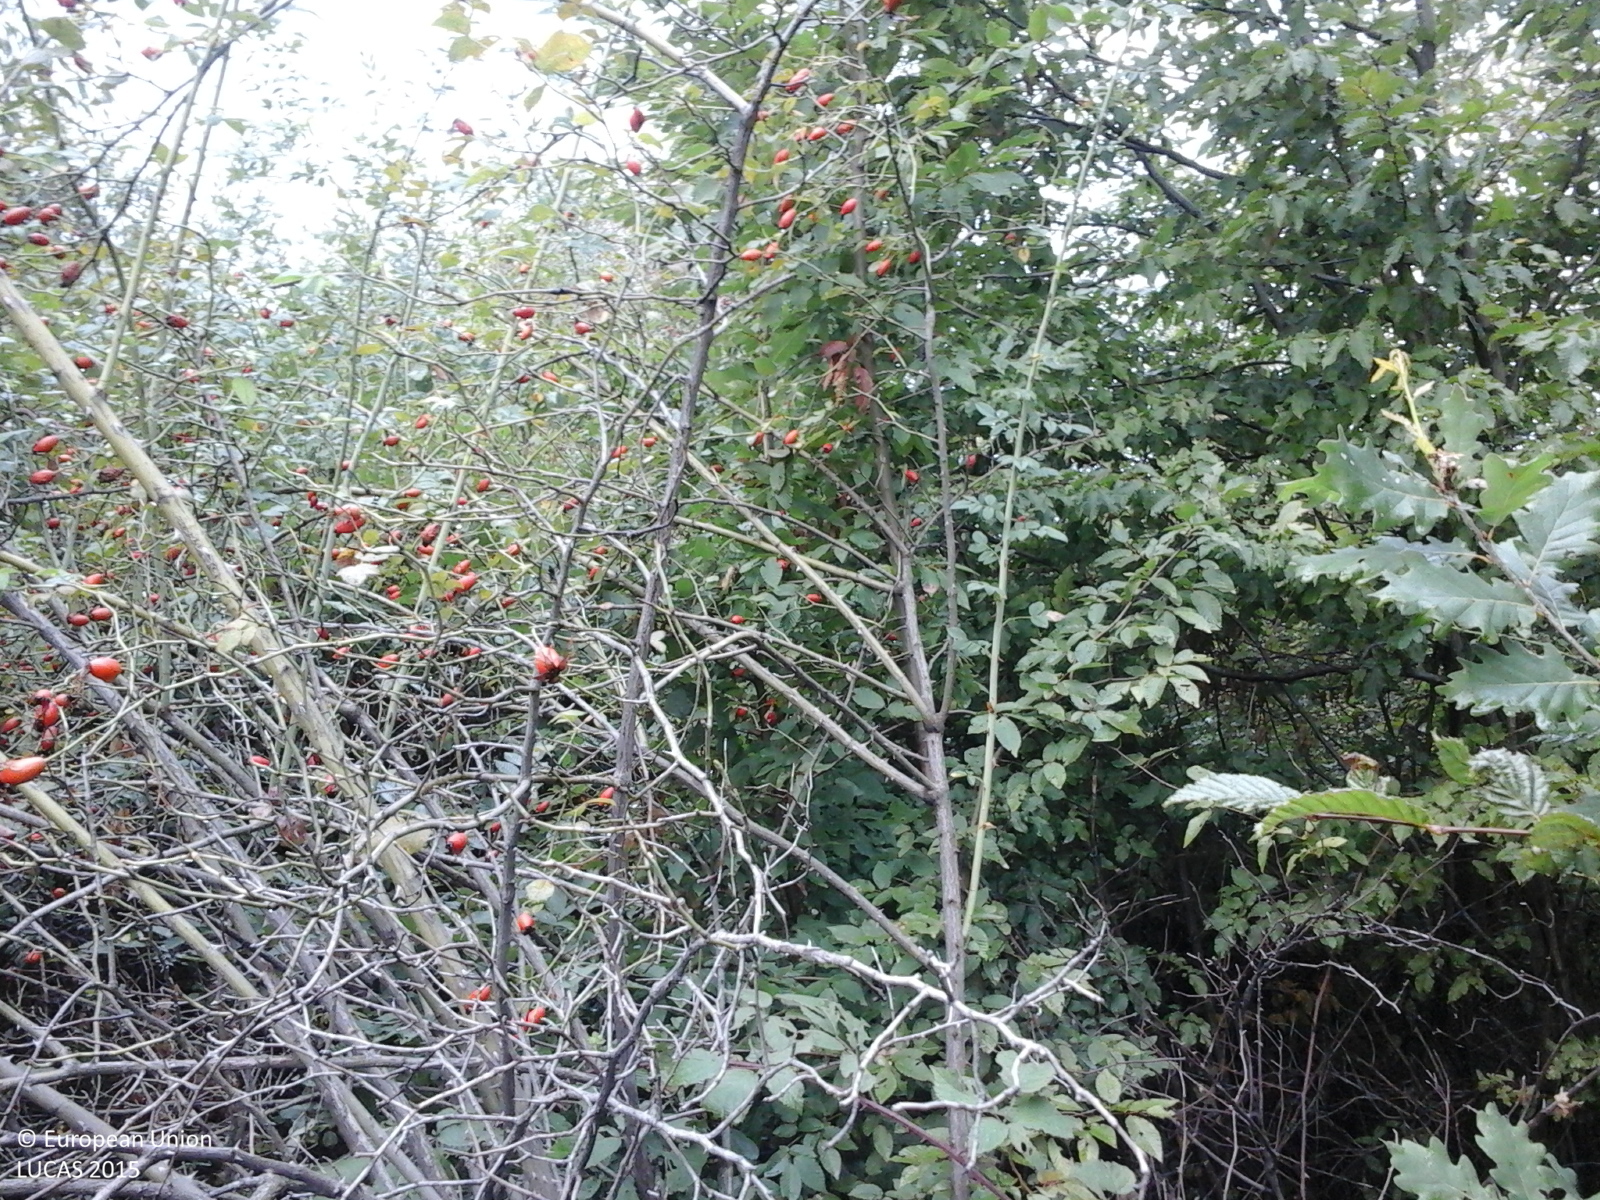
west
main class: Woodland
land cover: Broadleaved woodland
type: beech forest
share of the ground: > 75 %
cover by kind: broadleaved forest trees 100 %
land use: Forestry
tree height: > 5 m
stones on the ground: < 10 %
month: September
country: RO
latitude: 47.1343
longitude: 22.1128
